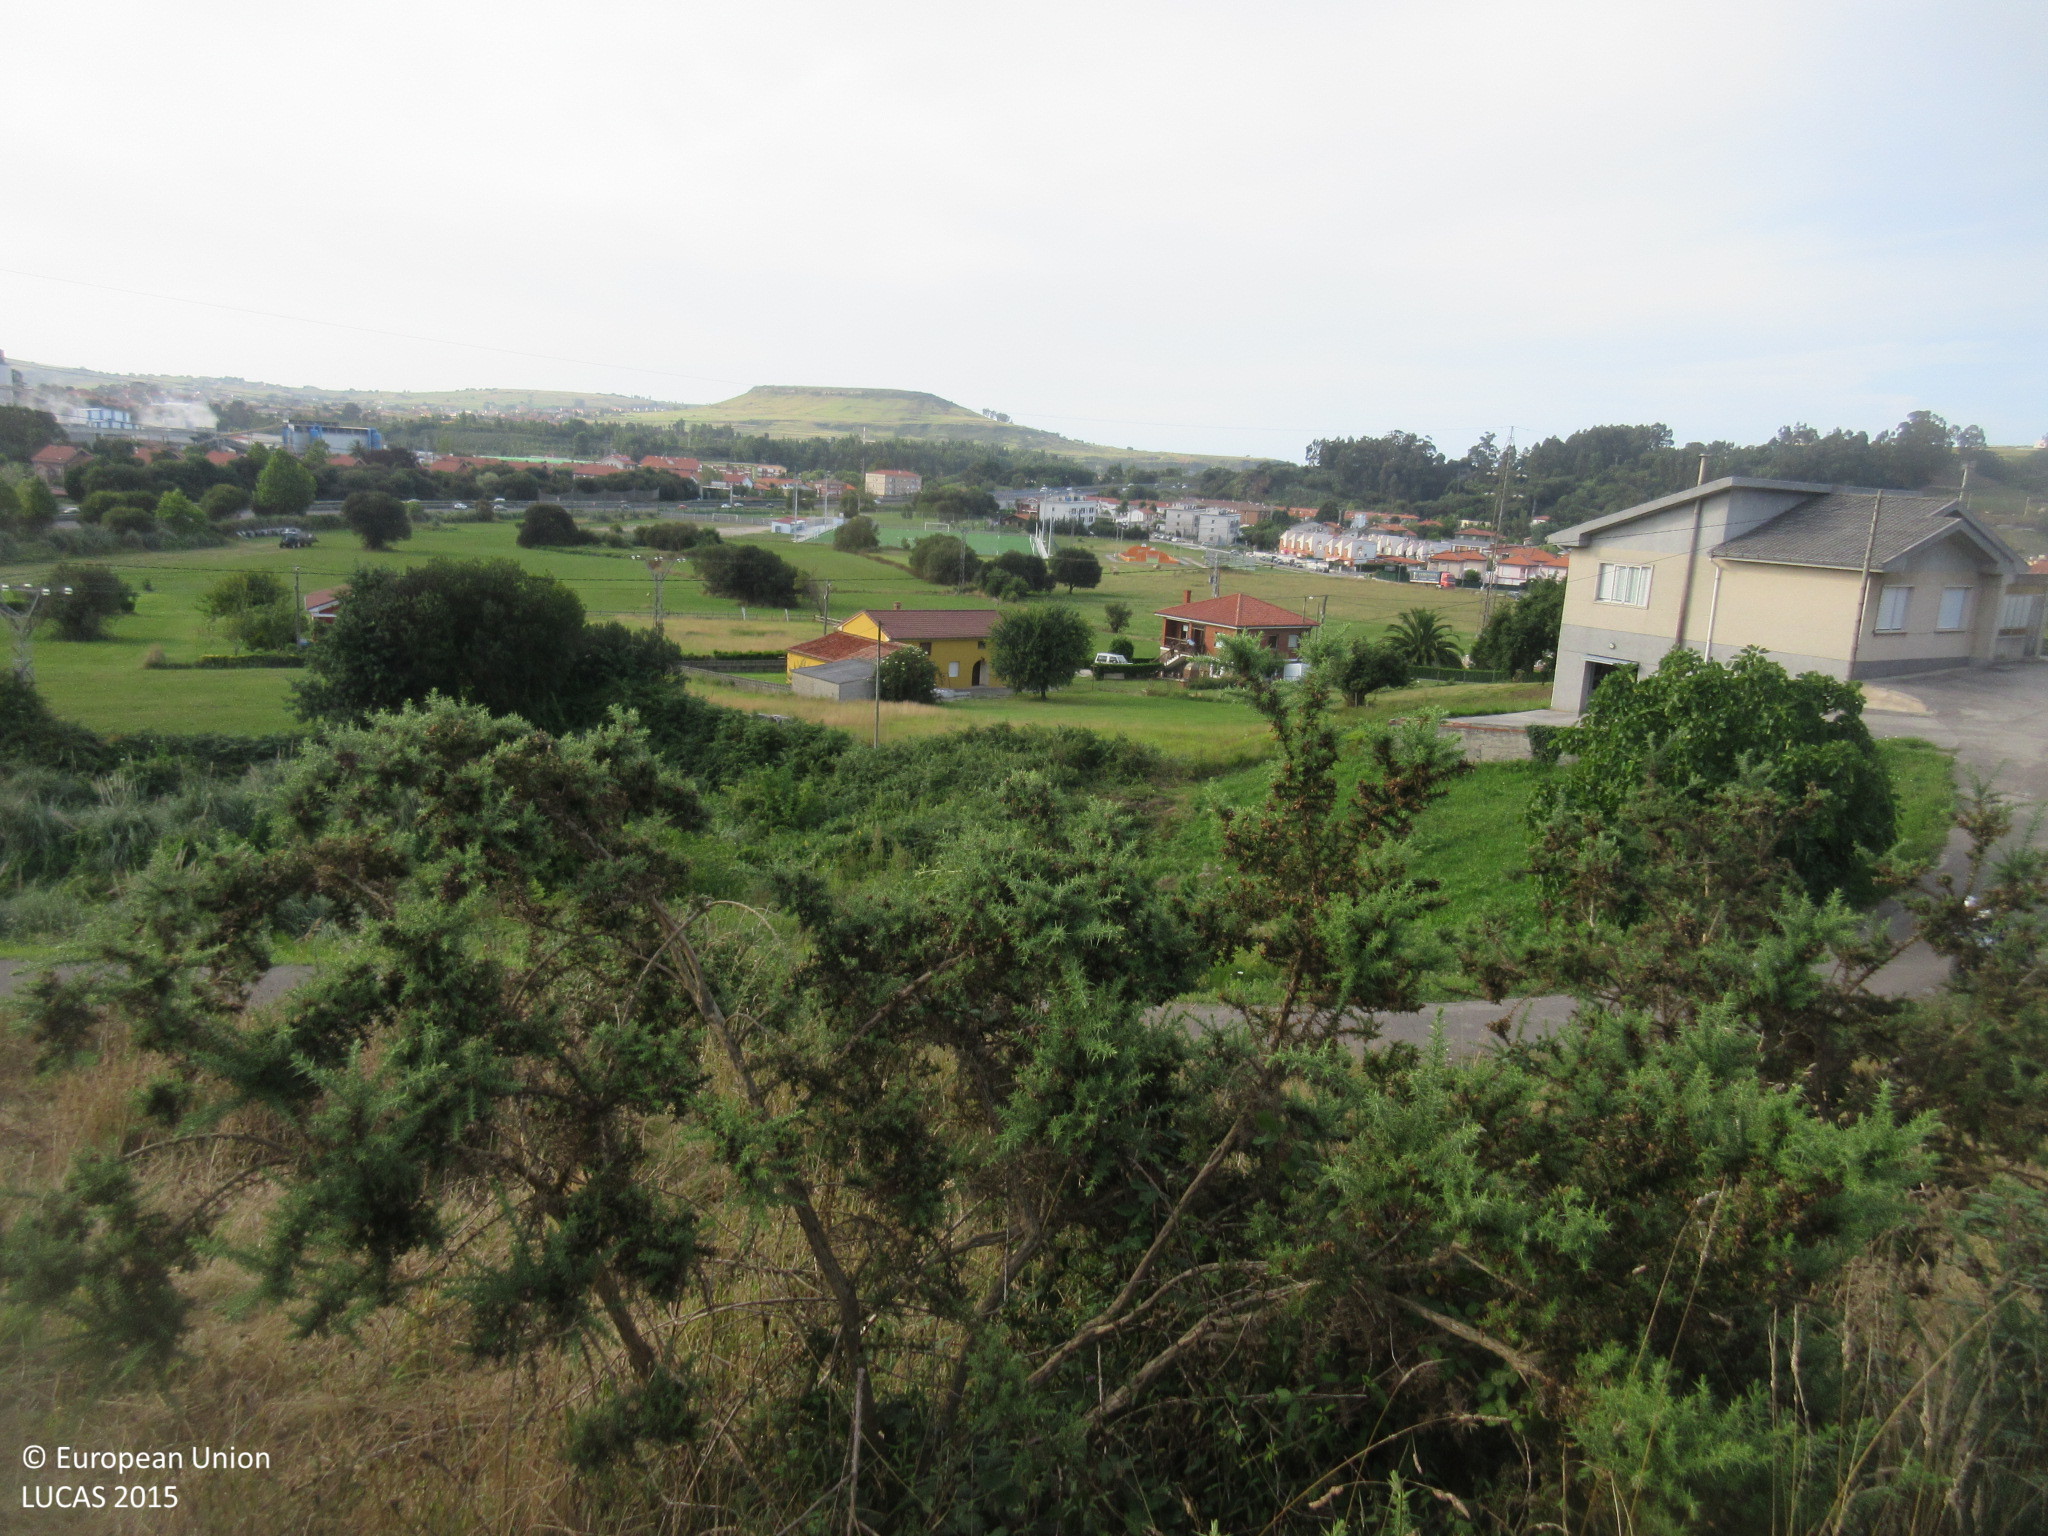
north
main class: Grassland
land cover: Grassland without tree/shrub cover
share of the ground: > 75 %
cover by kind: herbaceous plants 95 %, shrubs 5 %
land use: Agriculture (excluding fallow land and kitchen gardens)
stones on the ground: < 10 %
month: July
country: ES
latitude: 43.3729
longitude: -4.0352
